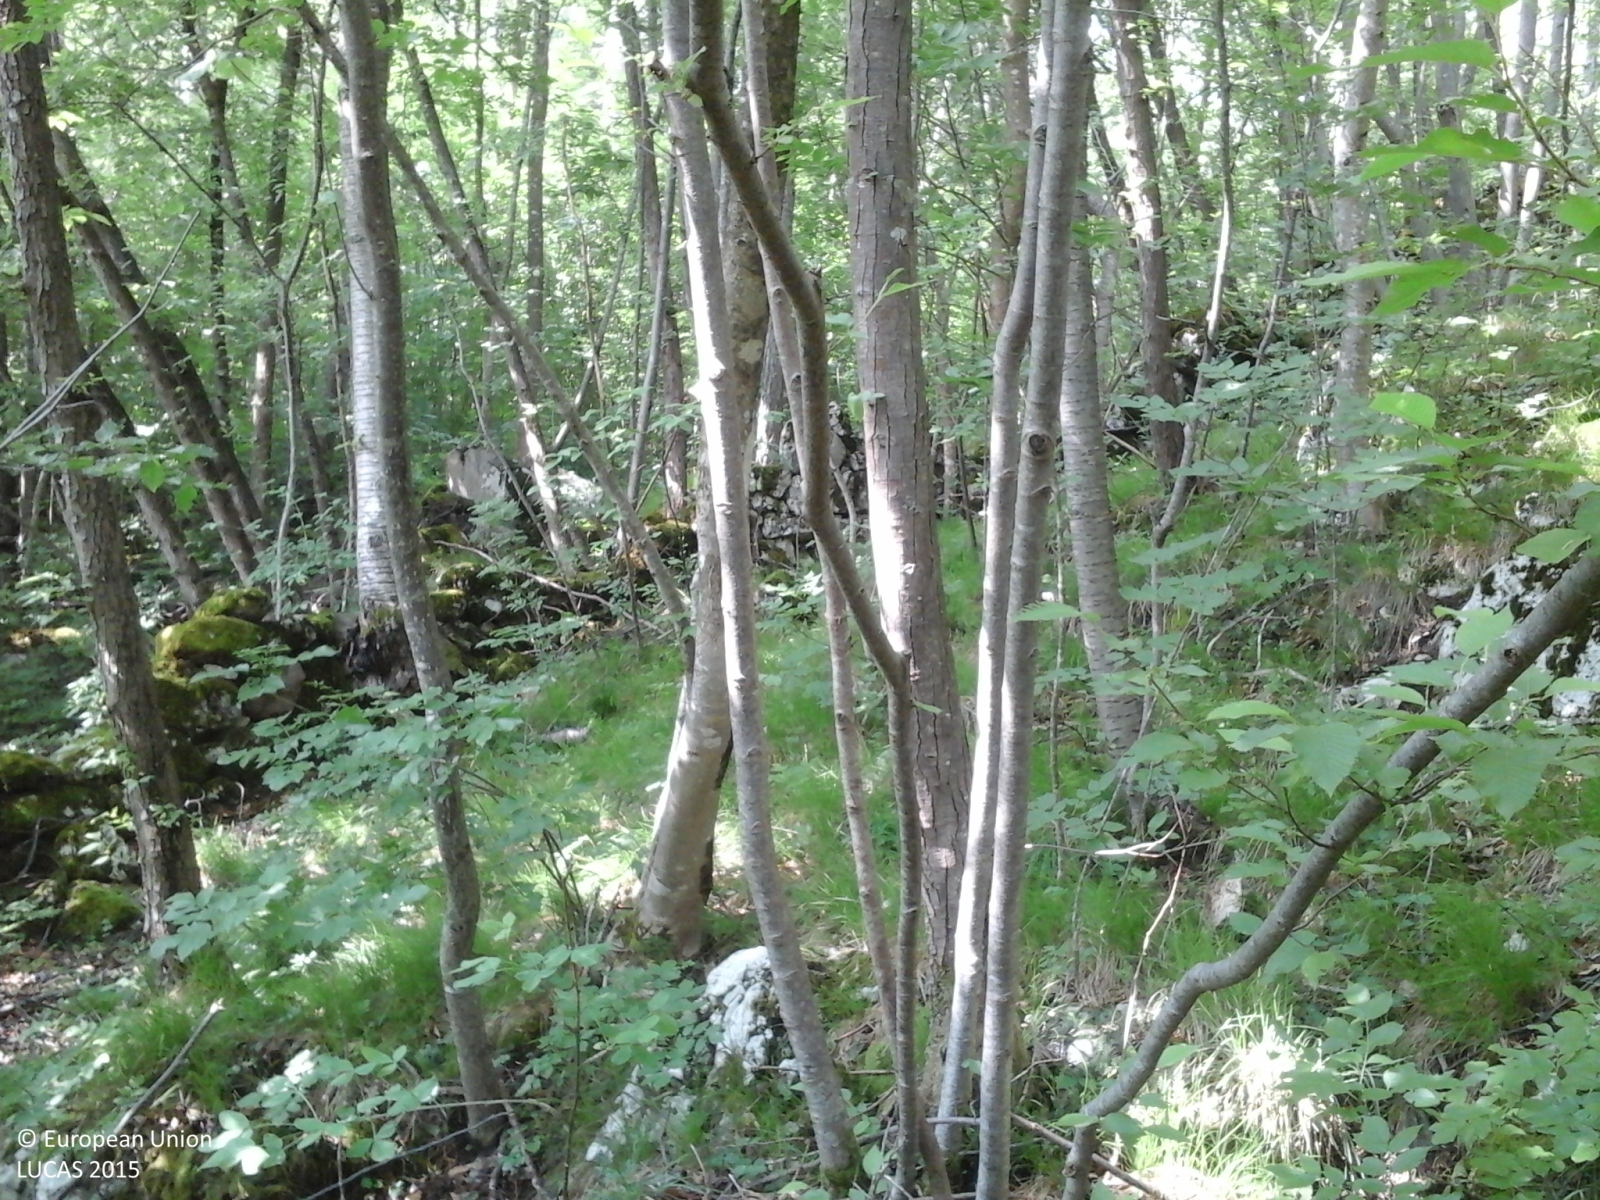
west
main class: Woodland
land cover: Broadleaved woodland
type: thermophilous deciduous forest
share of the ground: > 75 %
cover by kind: broadleaved forest trees 100 %
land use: Forestry
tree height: > 5 m
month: June
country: IT
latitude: 46.0033
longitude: 11.0960
